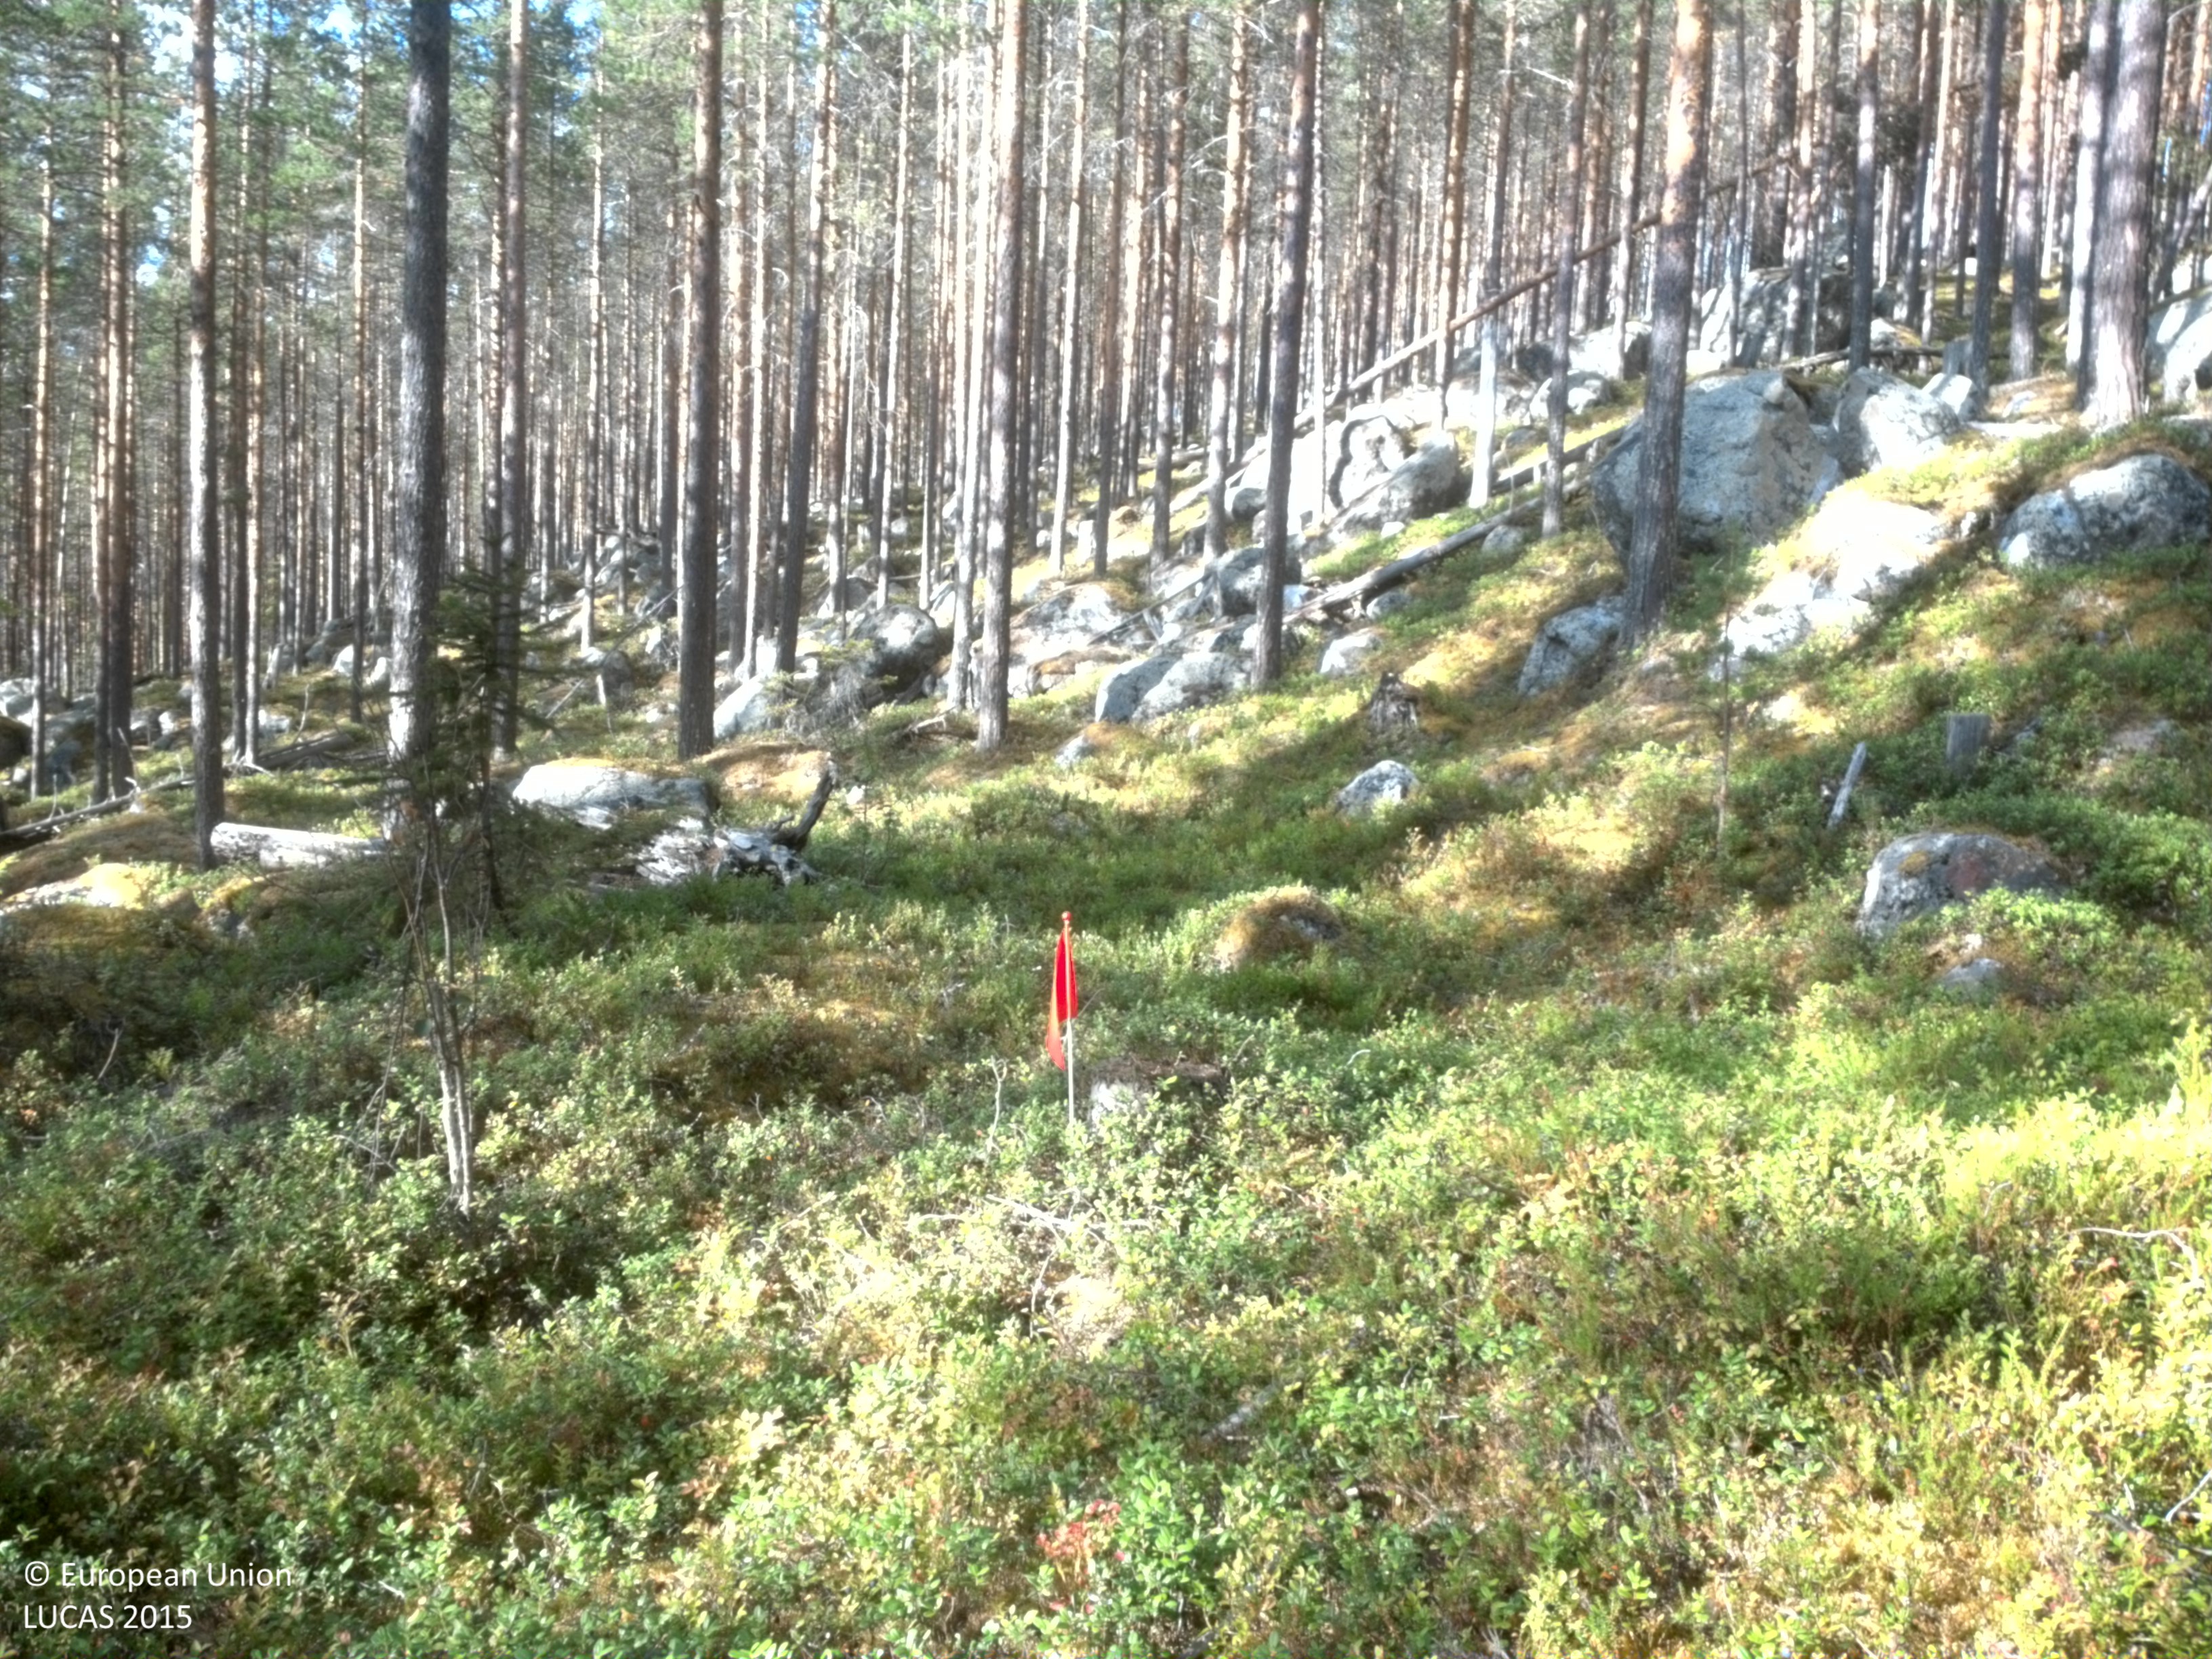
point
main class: Woodland
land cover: Pine dominated coniferous woodland
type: boreal forest
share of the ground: 50 - 75 %
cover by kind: coniferous forest trees 55 %, shrubs 30 %, lichens and mosses 15 %
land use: Forestry
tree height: > 5 m
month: September
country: SE
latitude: 64.4107
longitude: 19.0803
